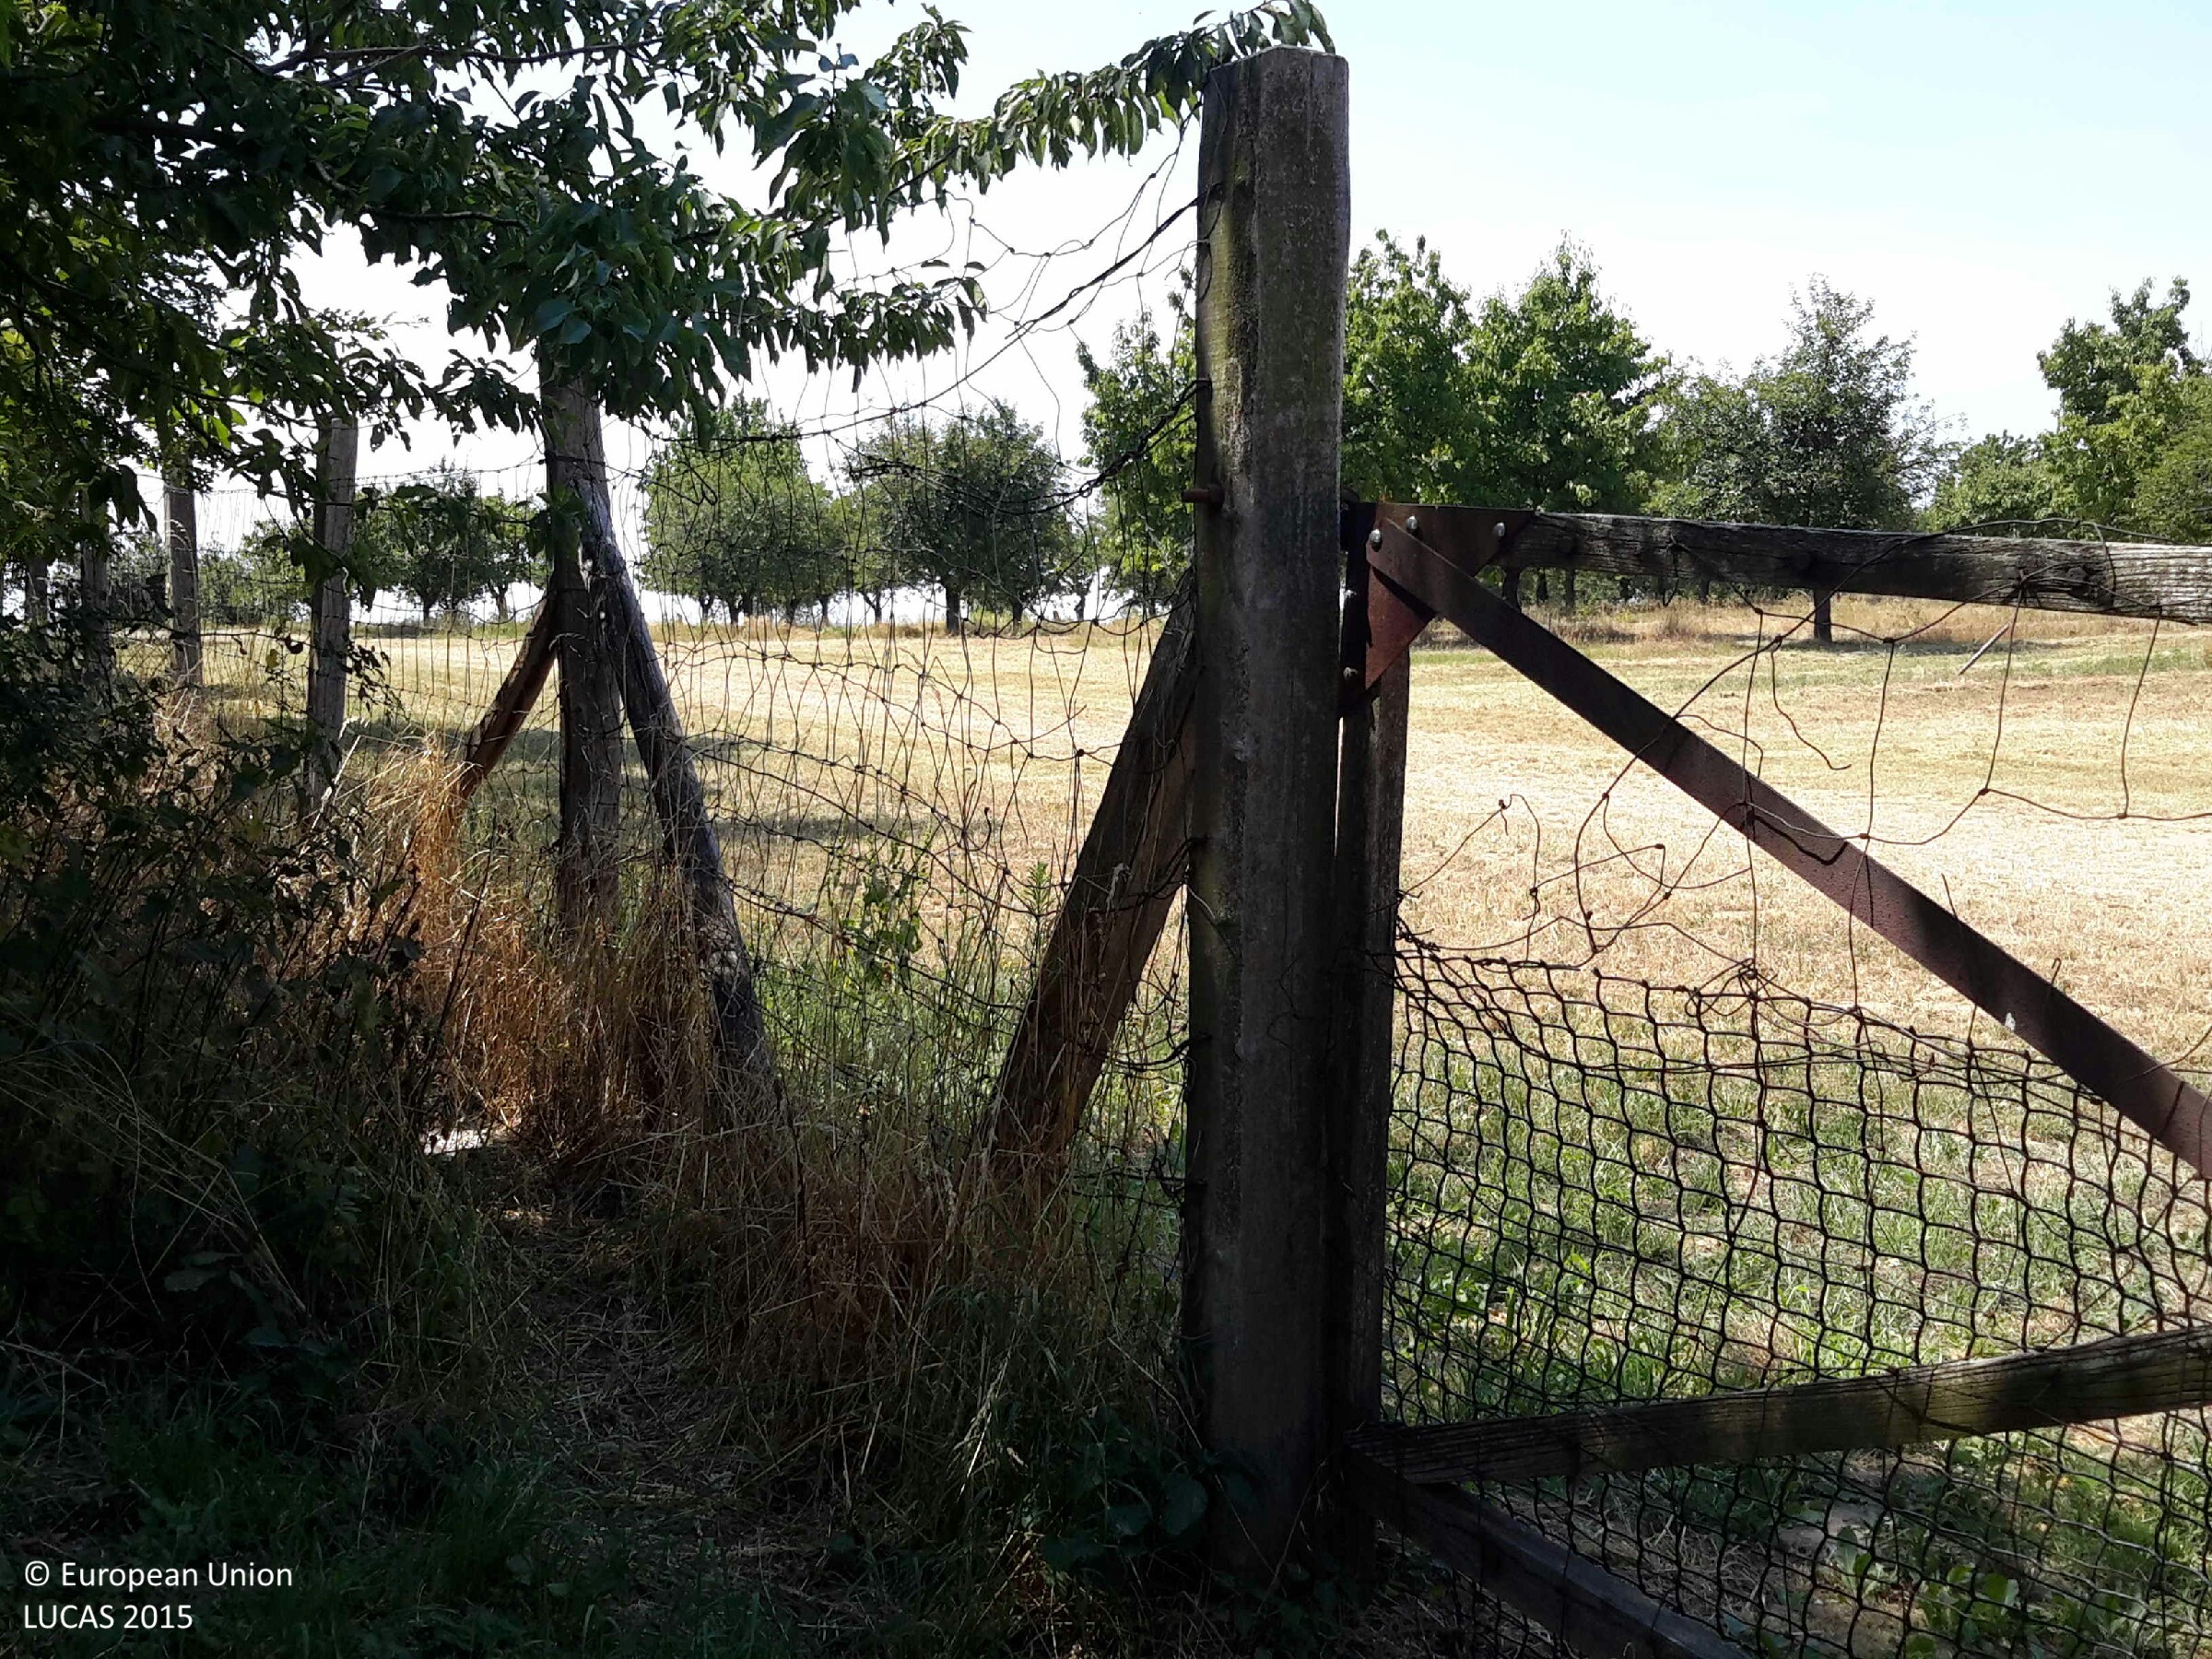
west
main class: Cropland
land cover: Permanent crops (only in case pi)
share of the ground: > 75 %
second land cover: Grassland without tree/shrub cover
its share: 50 - 75 %
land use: Agriculture (excluding fallow land and kitchen gardens)
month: July
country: HU
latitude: 47.4016
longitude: 17.8406
